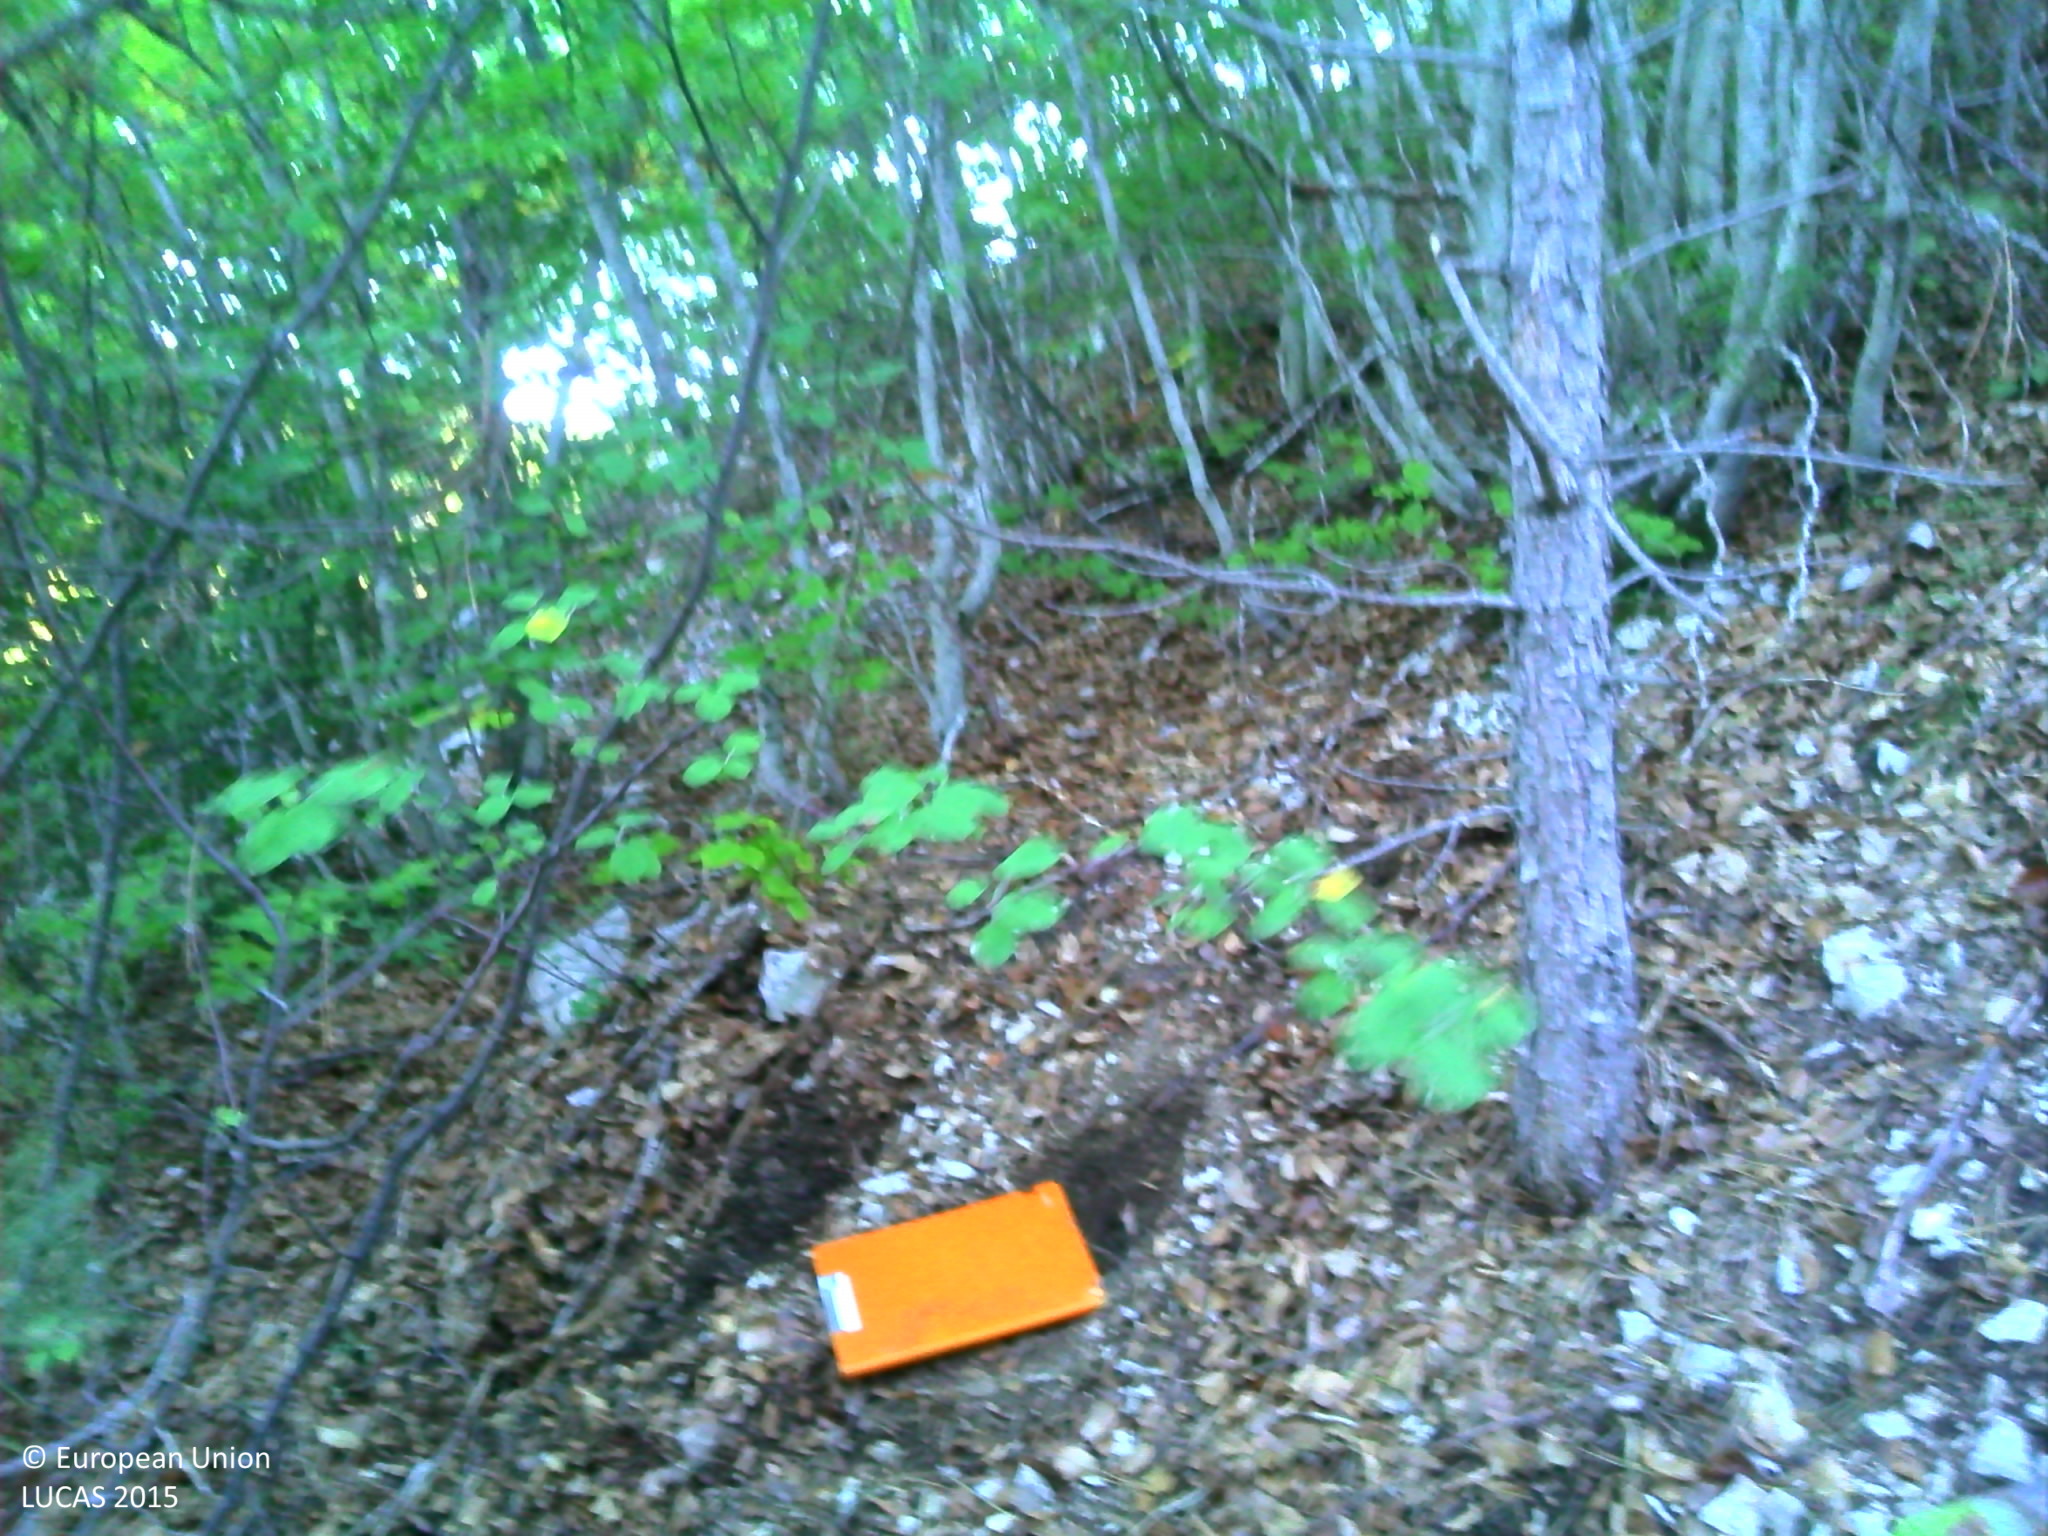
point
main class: Woodland
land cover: Broadleaved woodland
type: beech forest
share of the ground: > 75 %
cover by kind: broadleaved forest trees 85 %, unconsolidated bare surface 10 %, coniferous forest trees 5 %
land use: Semi-natural and natural areas not in use
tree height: > 5 m
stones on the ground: 10 - 25 %
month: September
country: FR
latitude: 44.1815
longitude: 5.5171
